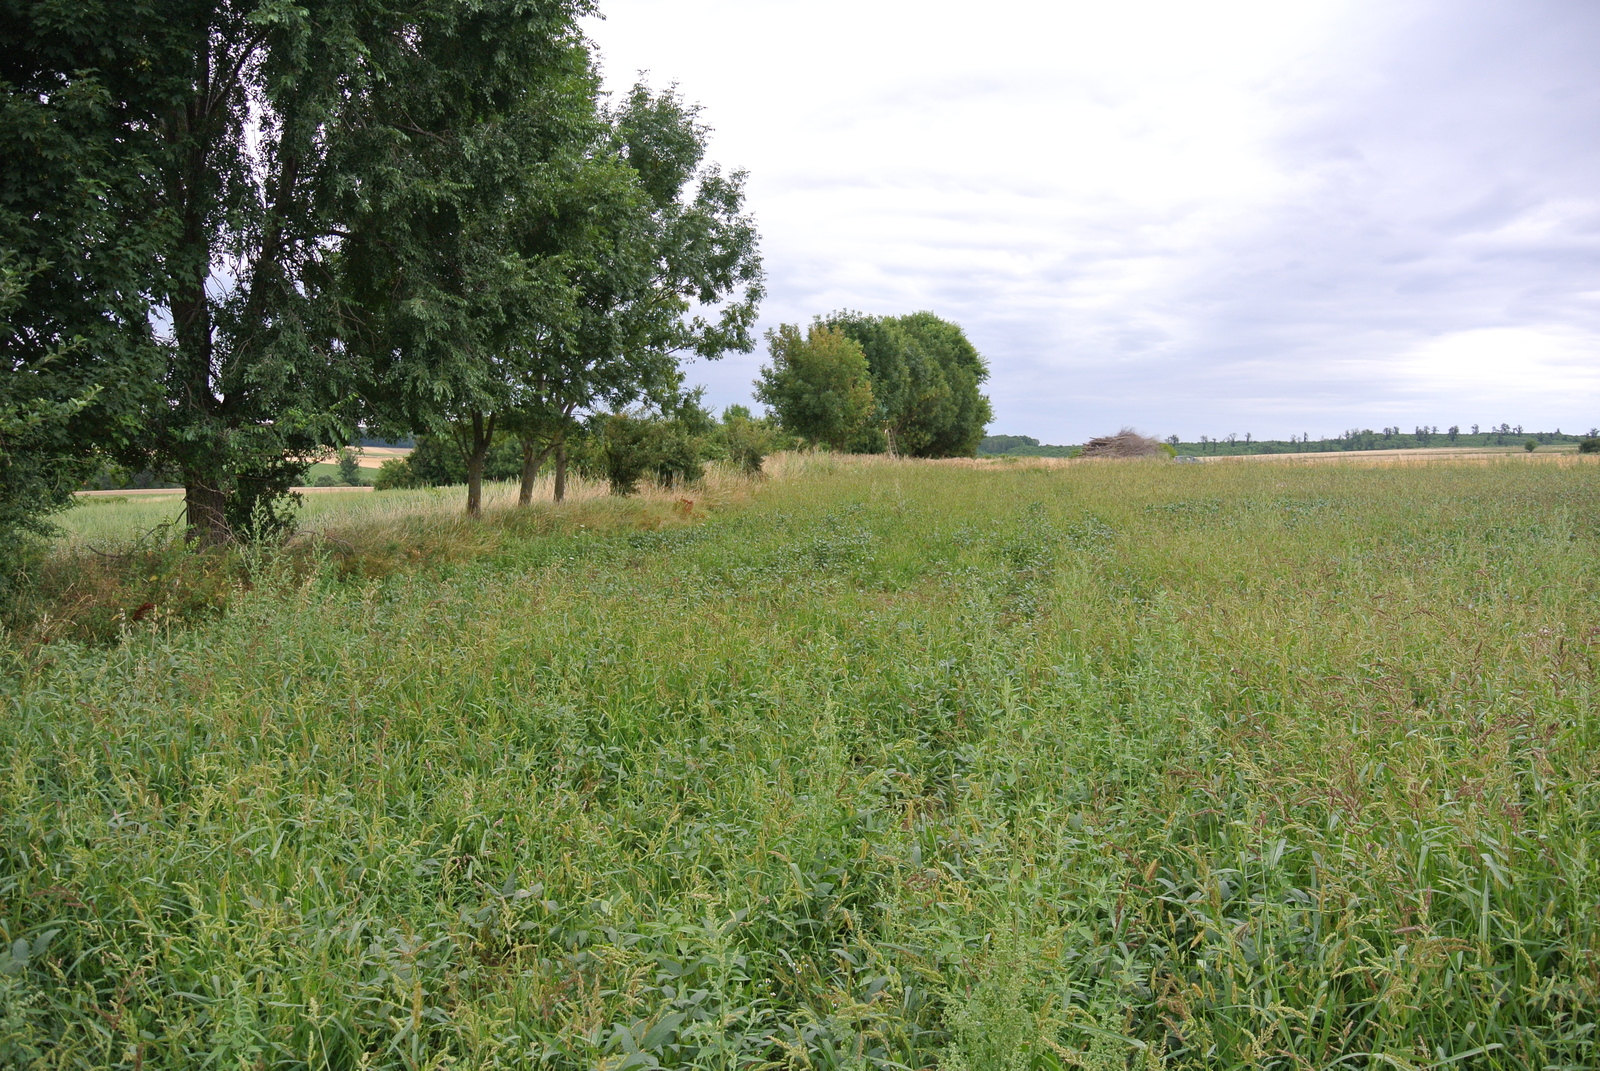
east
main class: Grassland
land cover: Spontaneously vegetated surfaces
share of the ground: > 75 %
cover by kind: herbaceous plants 100 %
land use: Agriculture (excluding fallow land and kitchen gardens)
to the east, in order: Spontaneously vegetated surfaces; Oats; Grass margins; Tracks; Grass margins; Spontaneously vegetated surfaces
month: July
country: AT
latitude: 47.5378
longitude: 16.6068
